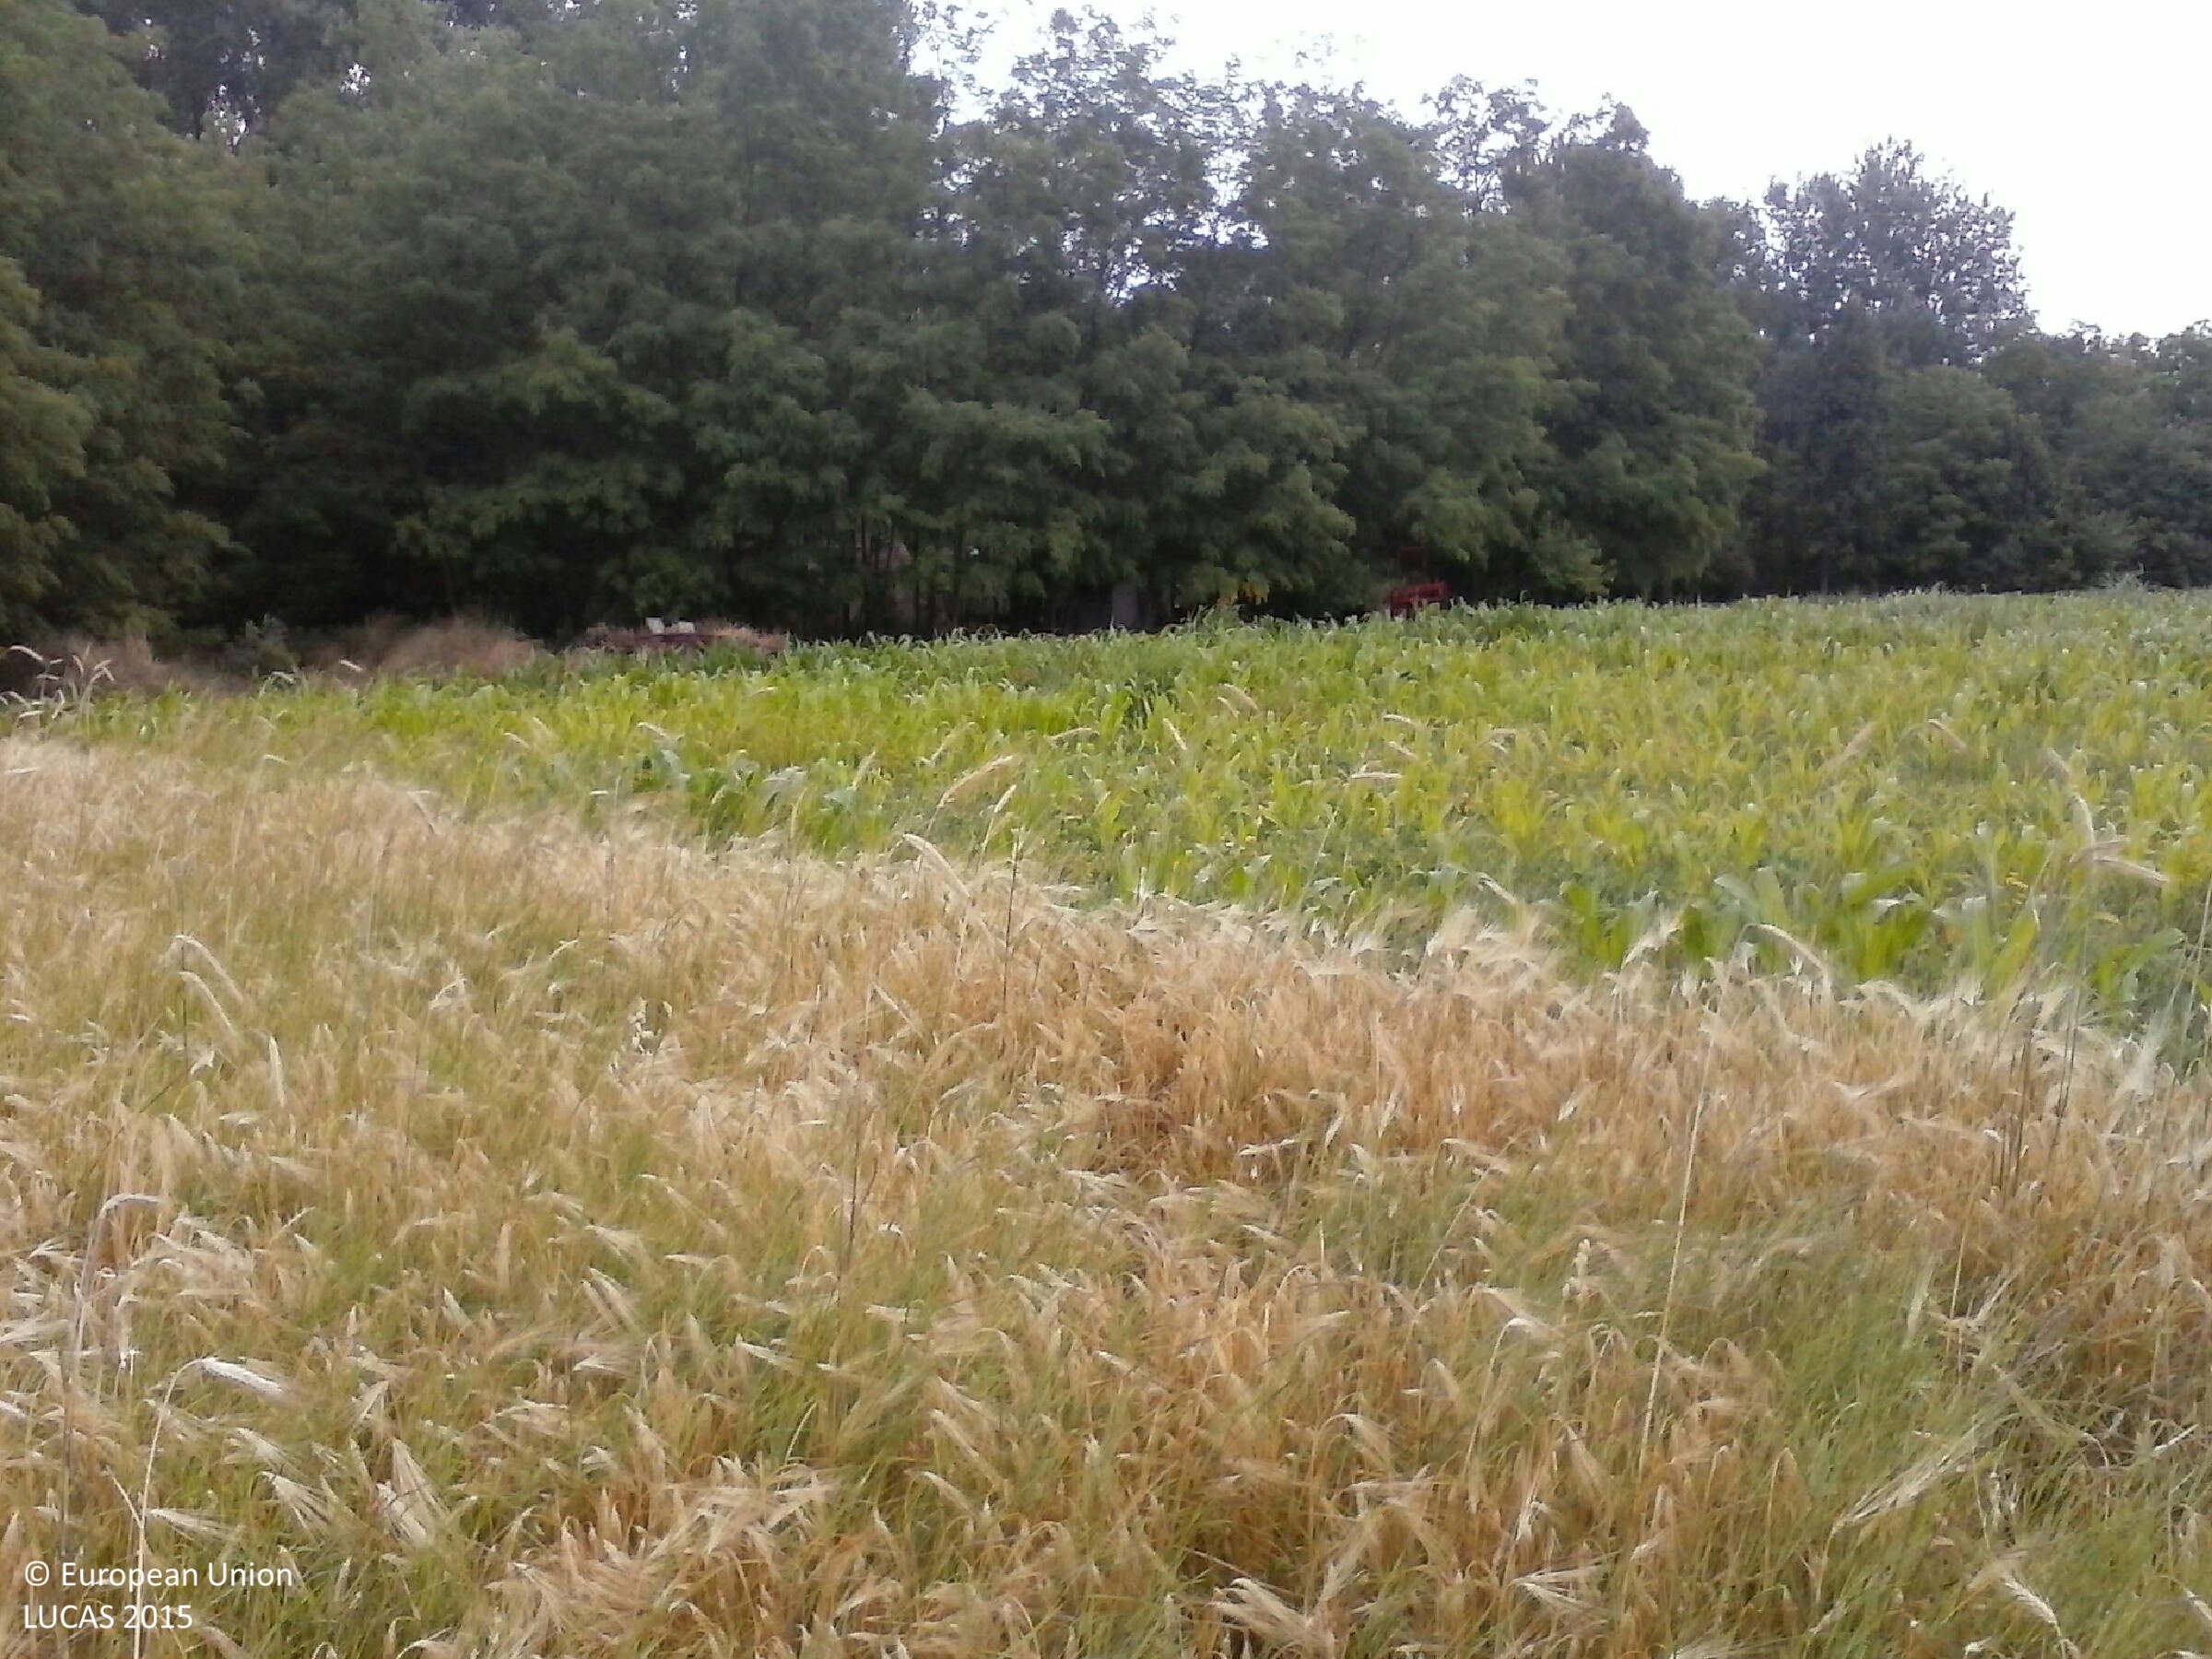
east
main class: Cropland
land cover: Barley
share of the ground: > 75 %
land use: Agriculture (excluding fallow land and kitchen gardens)
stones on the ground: < 10 %
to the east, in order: Barley; Maize; Grass margins; Broadleaved woodland; Artificial constructions in urban areas; Broadleaved woodland; Grassland without tree/shrub cover; Spontaneously vegetated surfaces; Ditches and canals; Spontaneously vegetated surfaces; Grassland without tree/shrub cover; Shruby margins; Tracks; Shruby margins
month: June
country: HU
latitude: 46.3162
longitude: 20.0076
